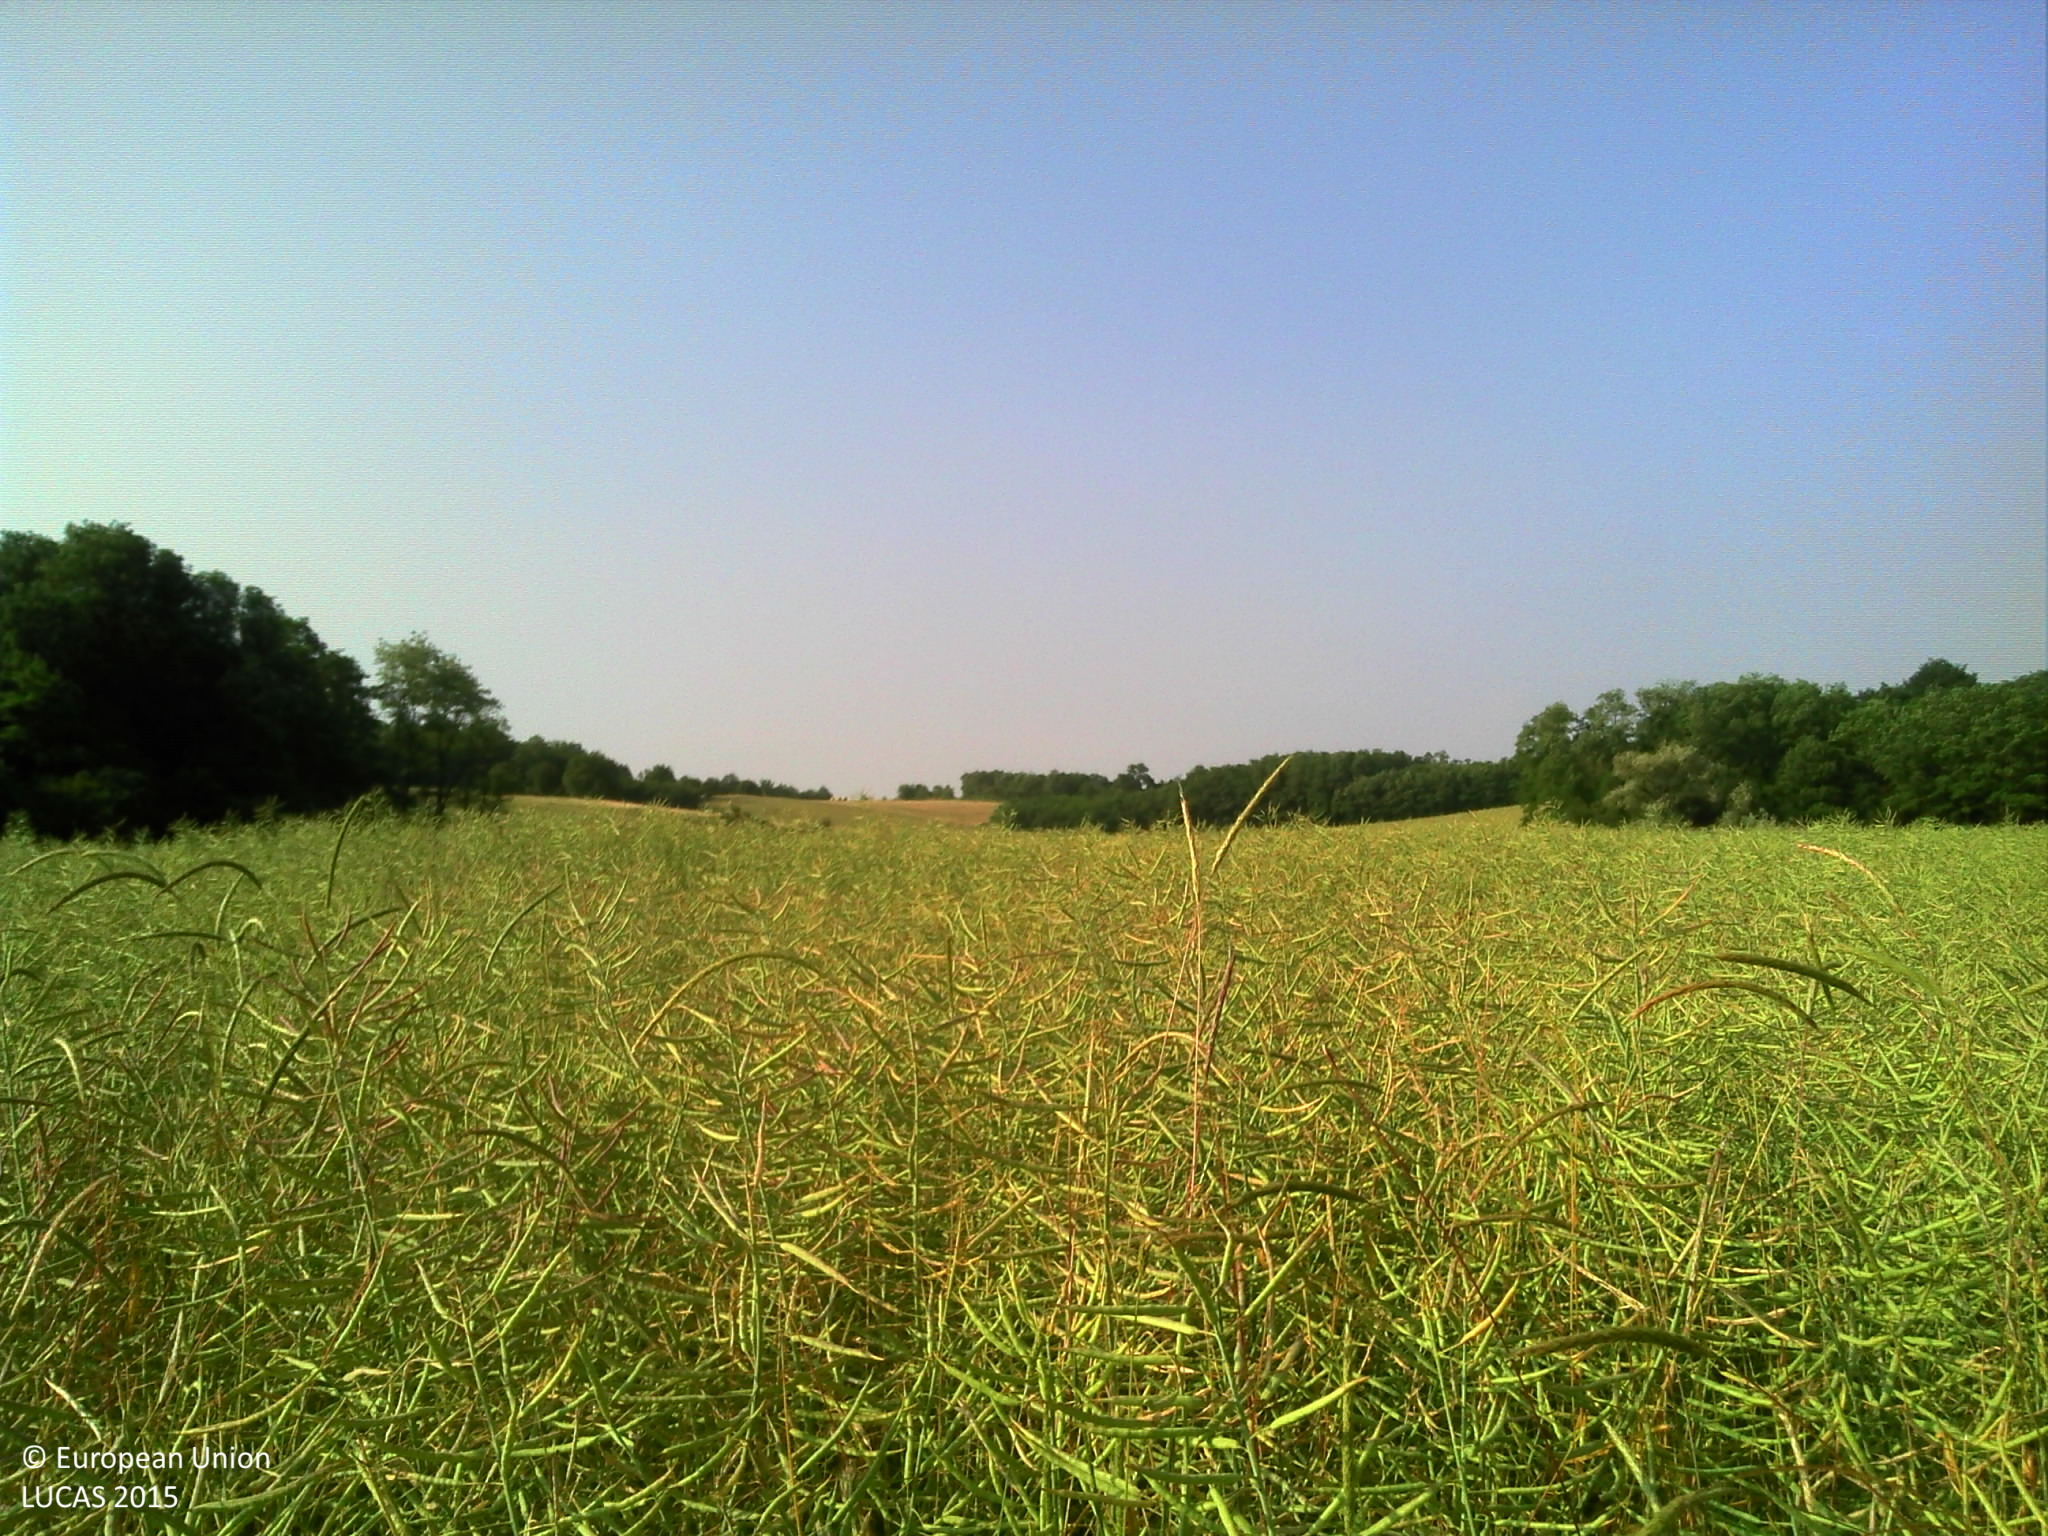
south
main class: Cropland
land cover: Rape and turnip rape
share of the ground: > 75 %
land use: Agriculture (excluding fallow land and kitchen gardens)
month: June
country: FR
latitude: 46.5173
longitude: 4.8794
